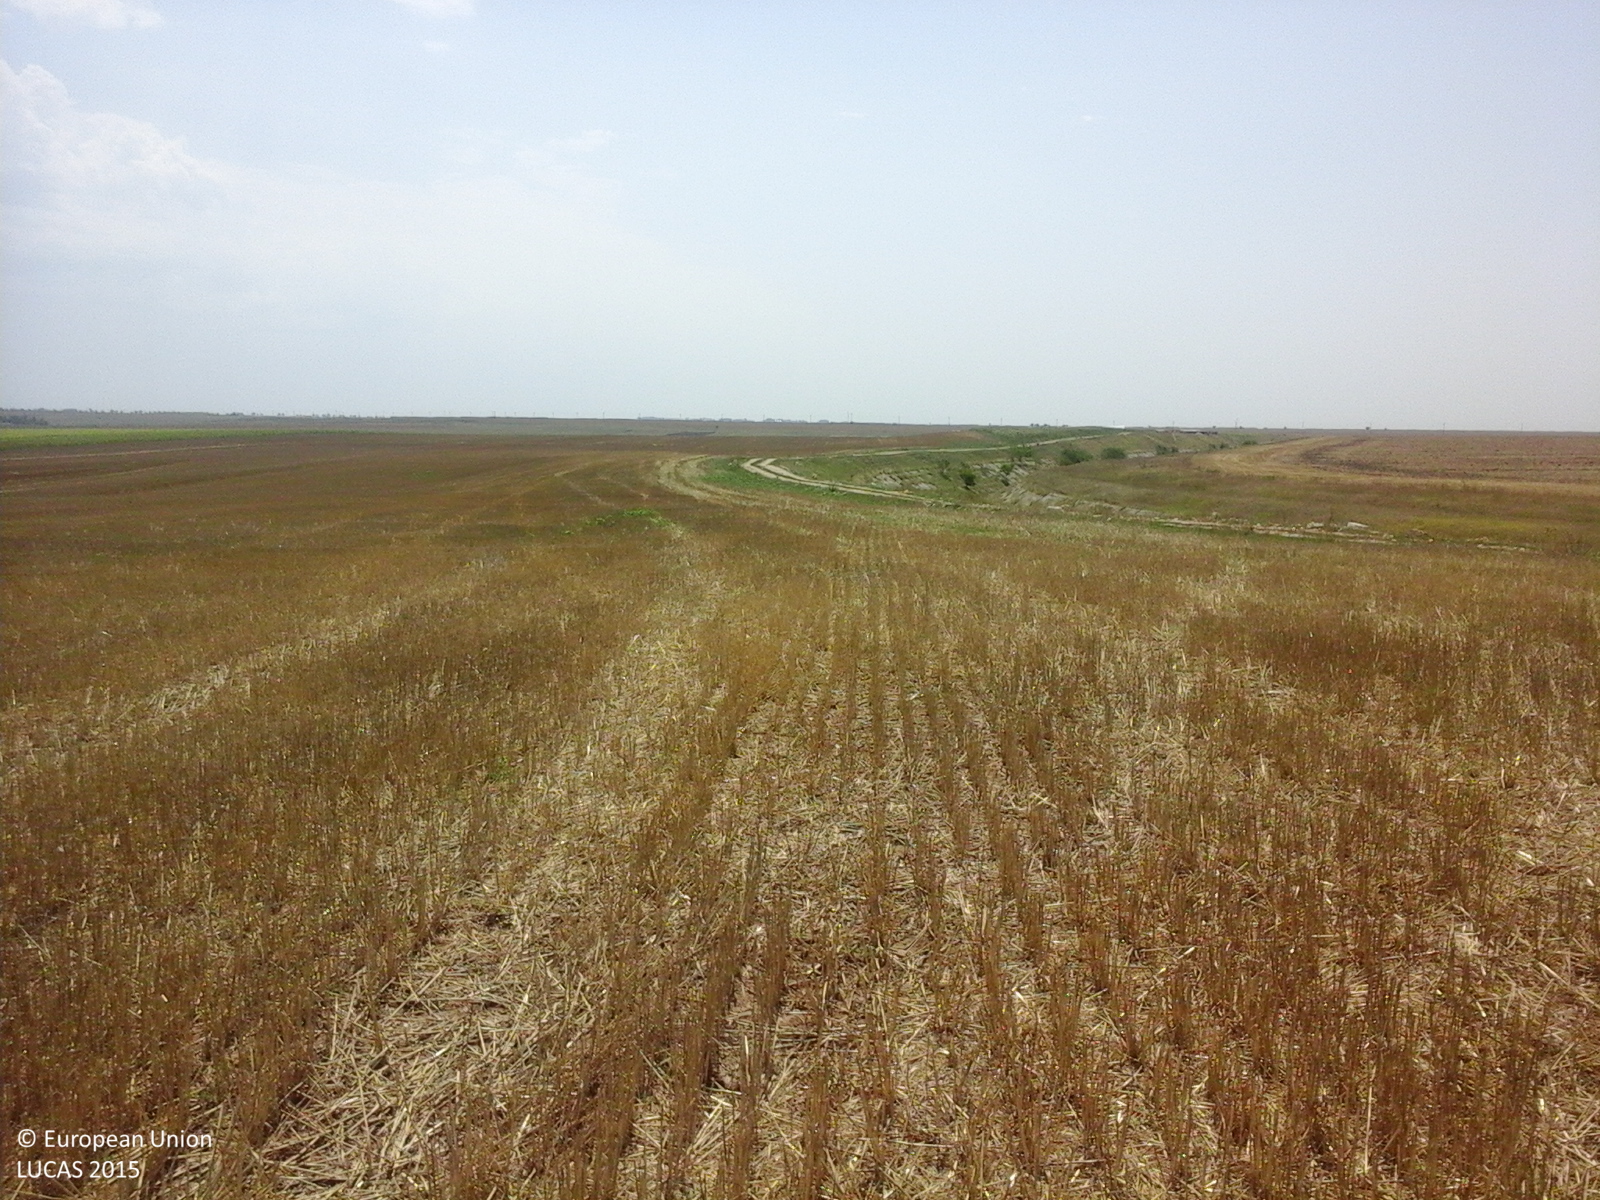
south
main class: Cropland
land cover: Common wheat
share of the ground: > 75 %
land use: Agriculture (excluding fallow land and kitchen gardens)
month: August
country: RO
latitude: 44.0797
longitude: 28.4616
